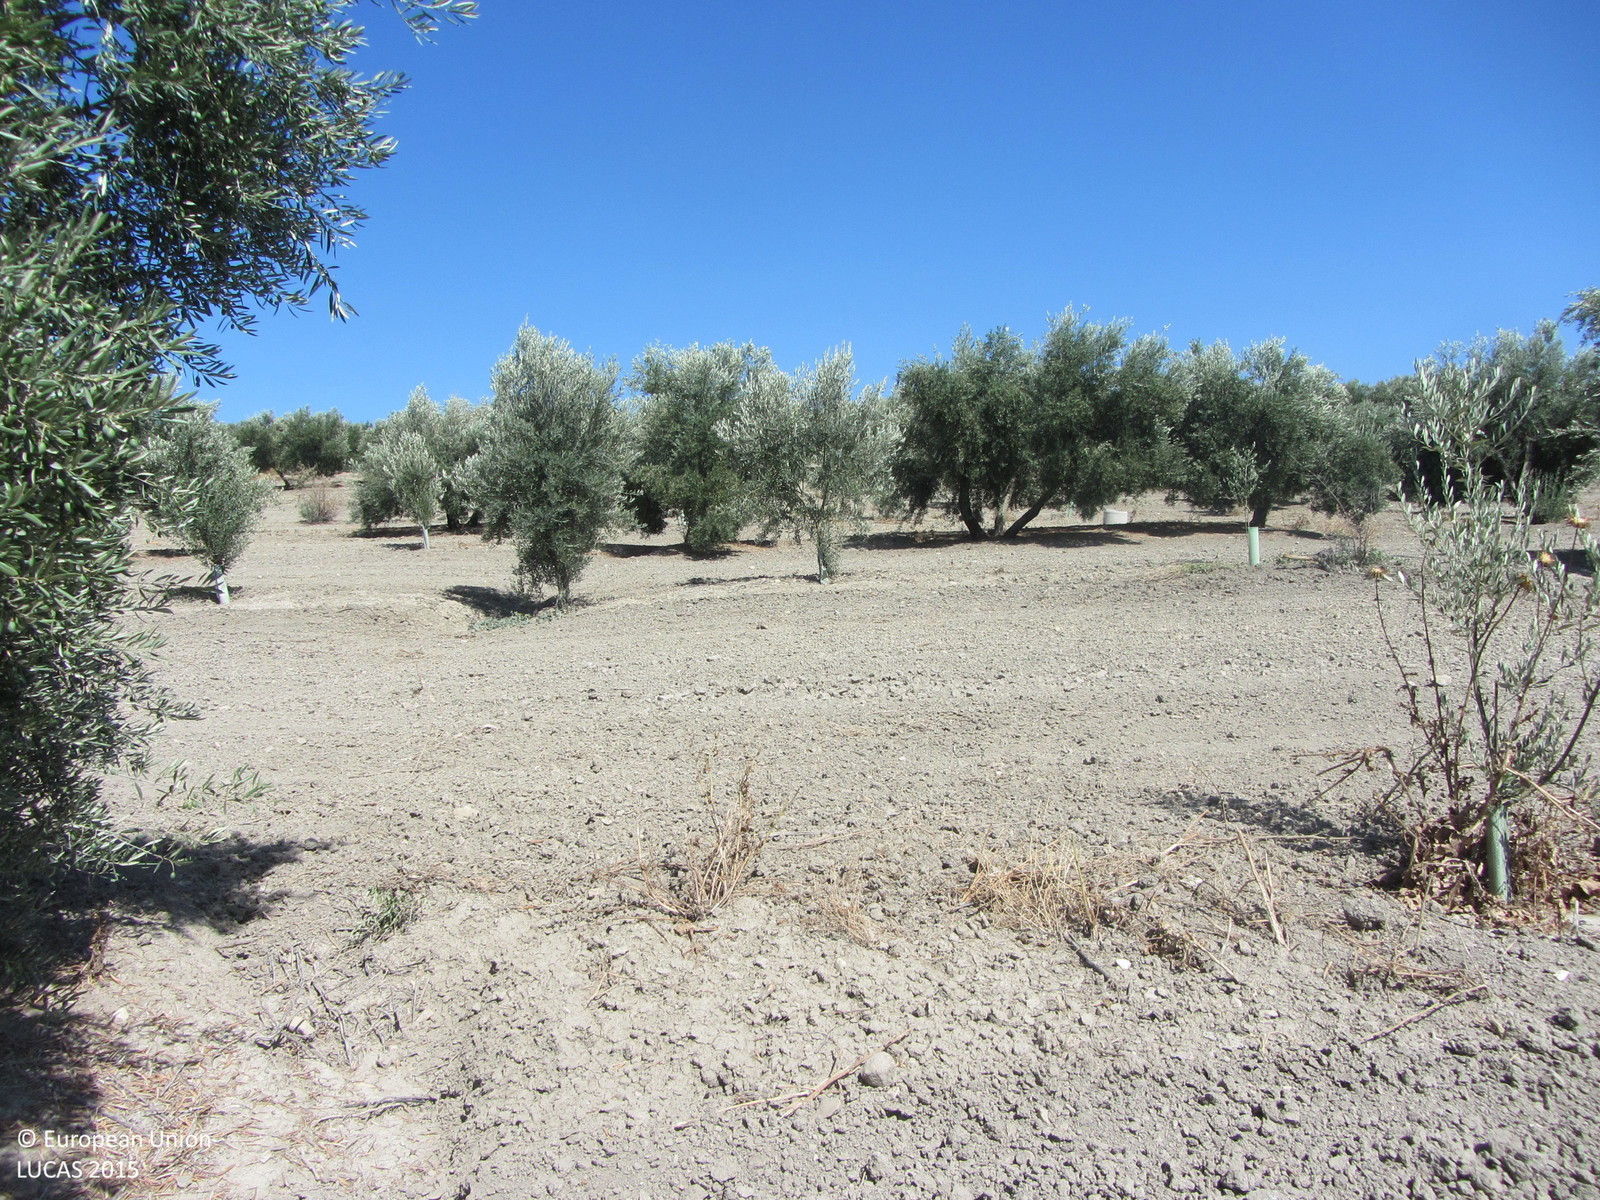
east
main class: Cropland
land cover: Olive groves
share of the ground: 10 - 25 %
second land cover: Other bare soil
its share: > 75 %
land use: Agriculture (excluding fallow land and kitchen gardens)
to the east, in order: Olive groves; Other bare soil; Other structural elements; Olive groves
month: July
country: ES
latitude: 37.9907
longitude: -3.8852
